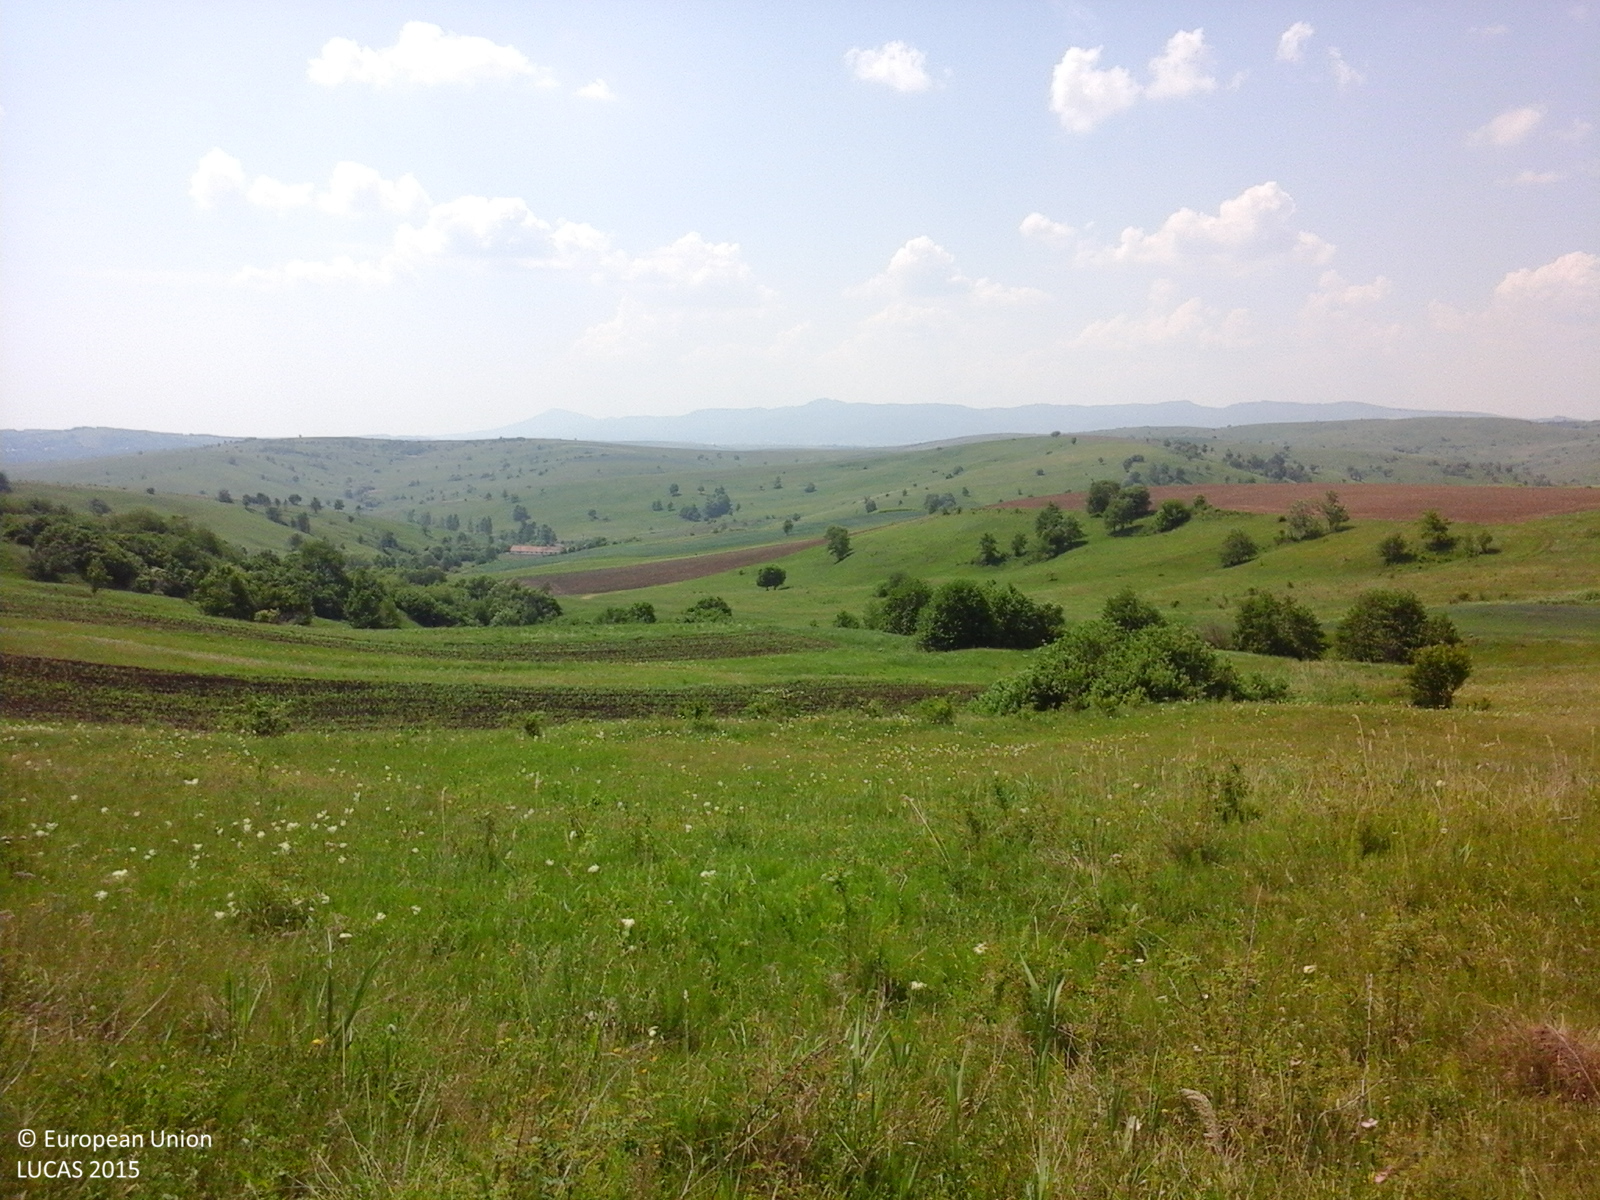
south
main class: Grassland
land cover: Grassland without tree/shrub cover
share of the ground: > 75 %
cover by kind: herbaceous plants 100 %
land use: Agriculture (excluding fallow land and kitchen gardens)
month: June
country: RO
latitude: 46.5556
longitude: 26.5580
